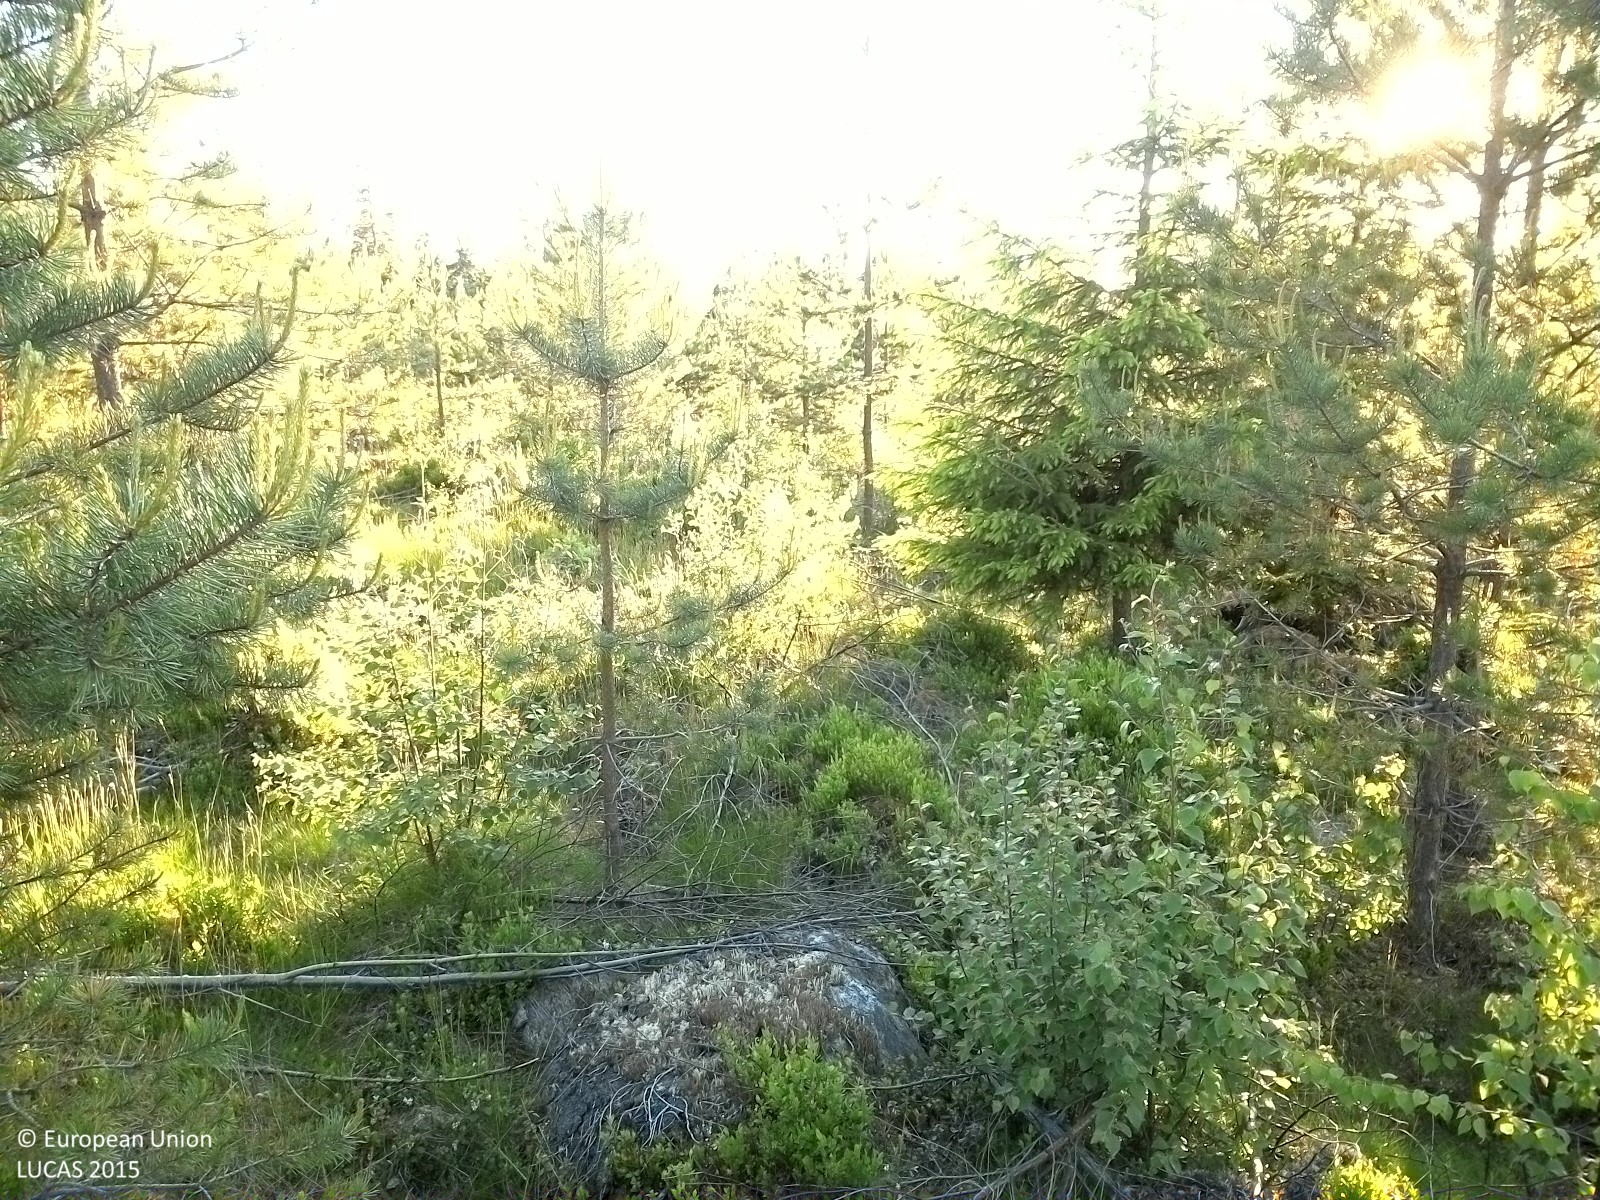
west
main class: Woodland
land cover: Pine dominated coniferous woodland
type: boreal forest
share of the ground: 25 - 50 %
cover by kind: coniferous forest trees 35 %, herbaceous plants 25 %, shrubs 20 %, lichens and mosses 20 %
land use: Forestry
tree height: < 5 m
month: June
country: SE
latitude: 62.0997
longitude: 16.3219
